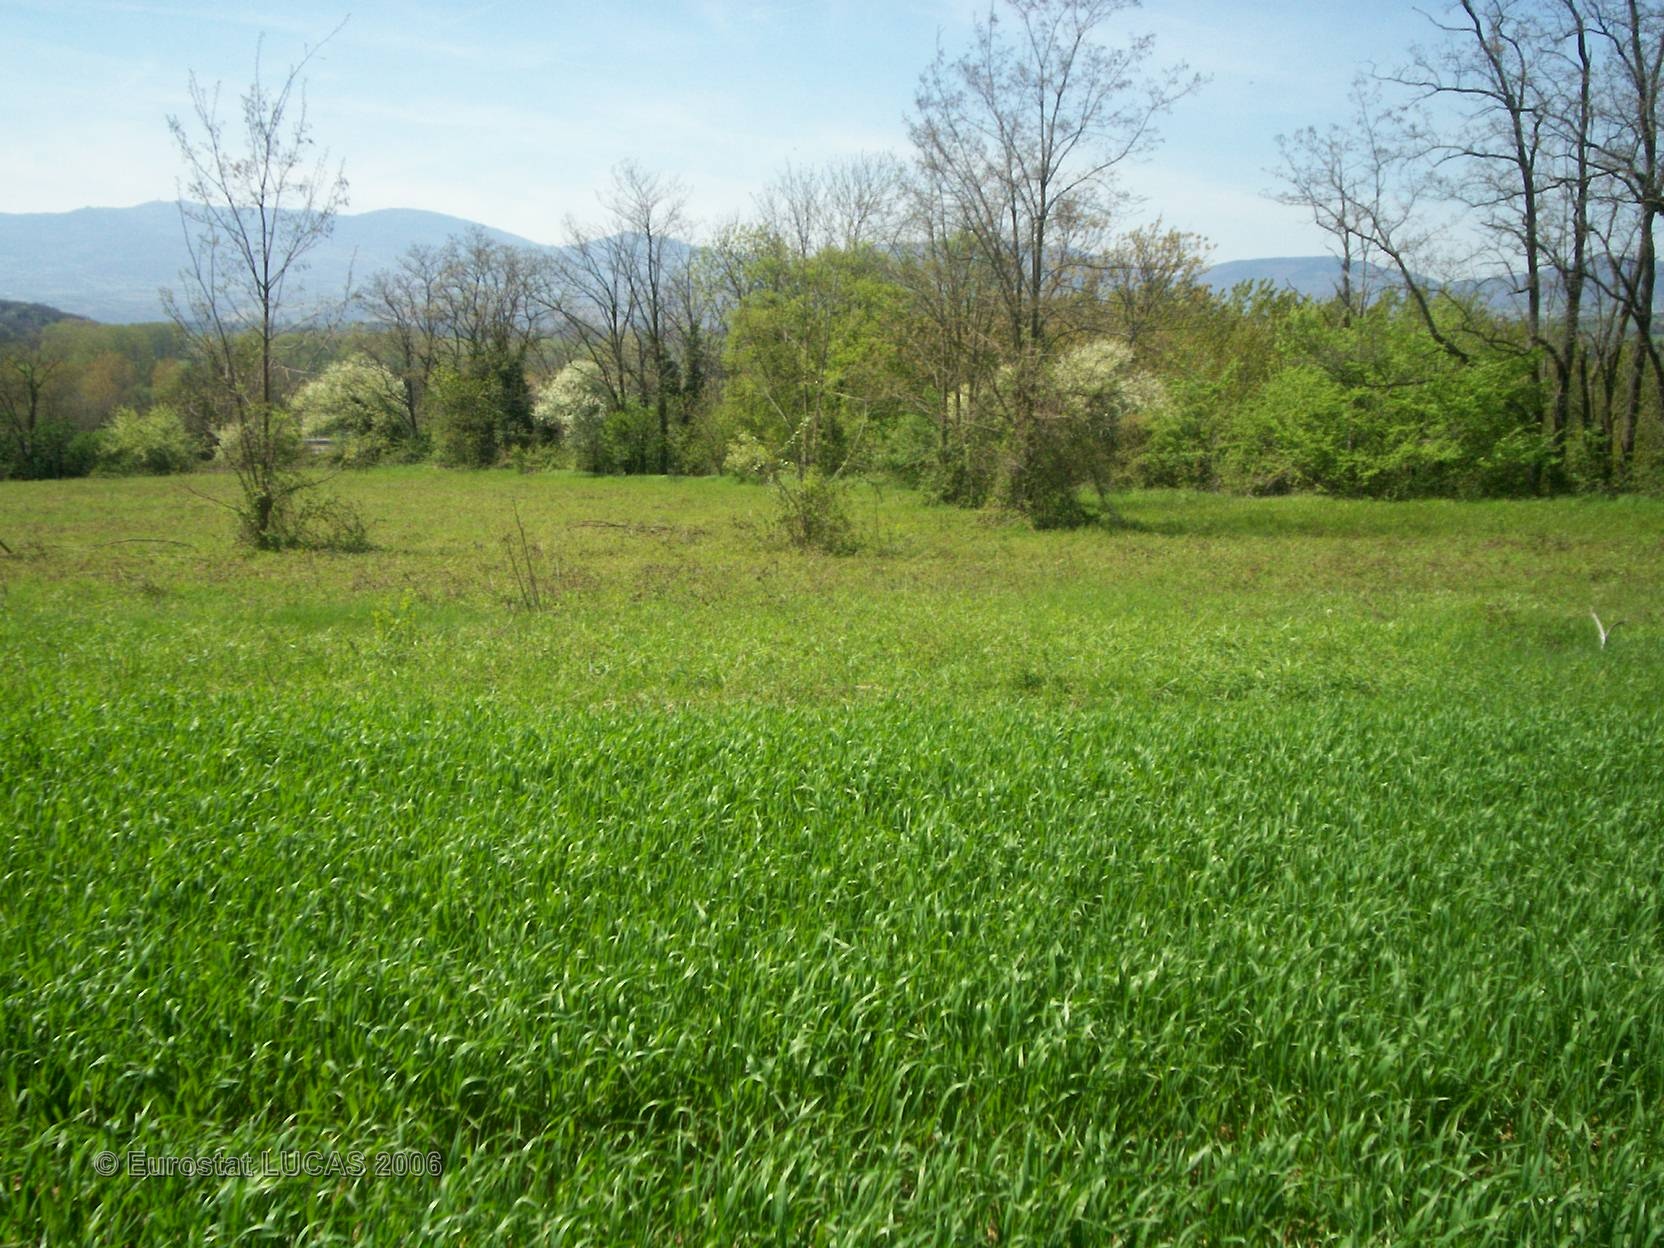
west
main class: Cropland
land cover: Common wheat
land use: Agriculture (excluding fallow land and kitchen gardens)
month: April
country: FR
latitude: 45.4318
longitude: 4.8276
